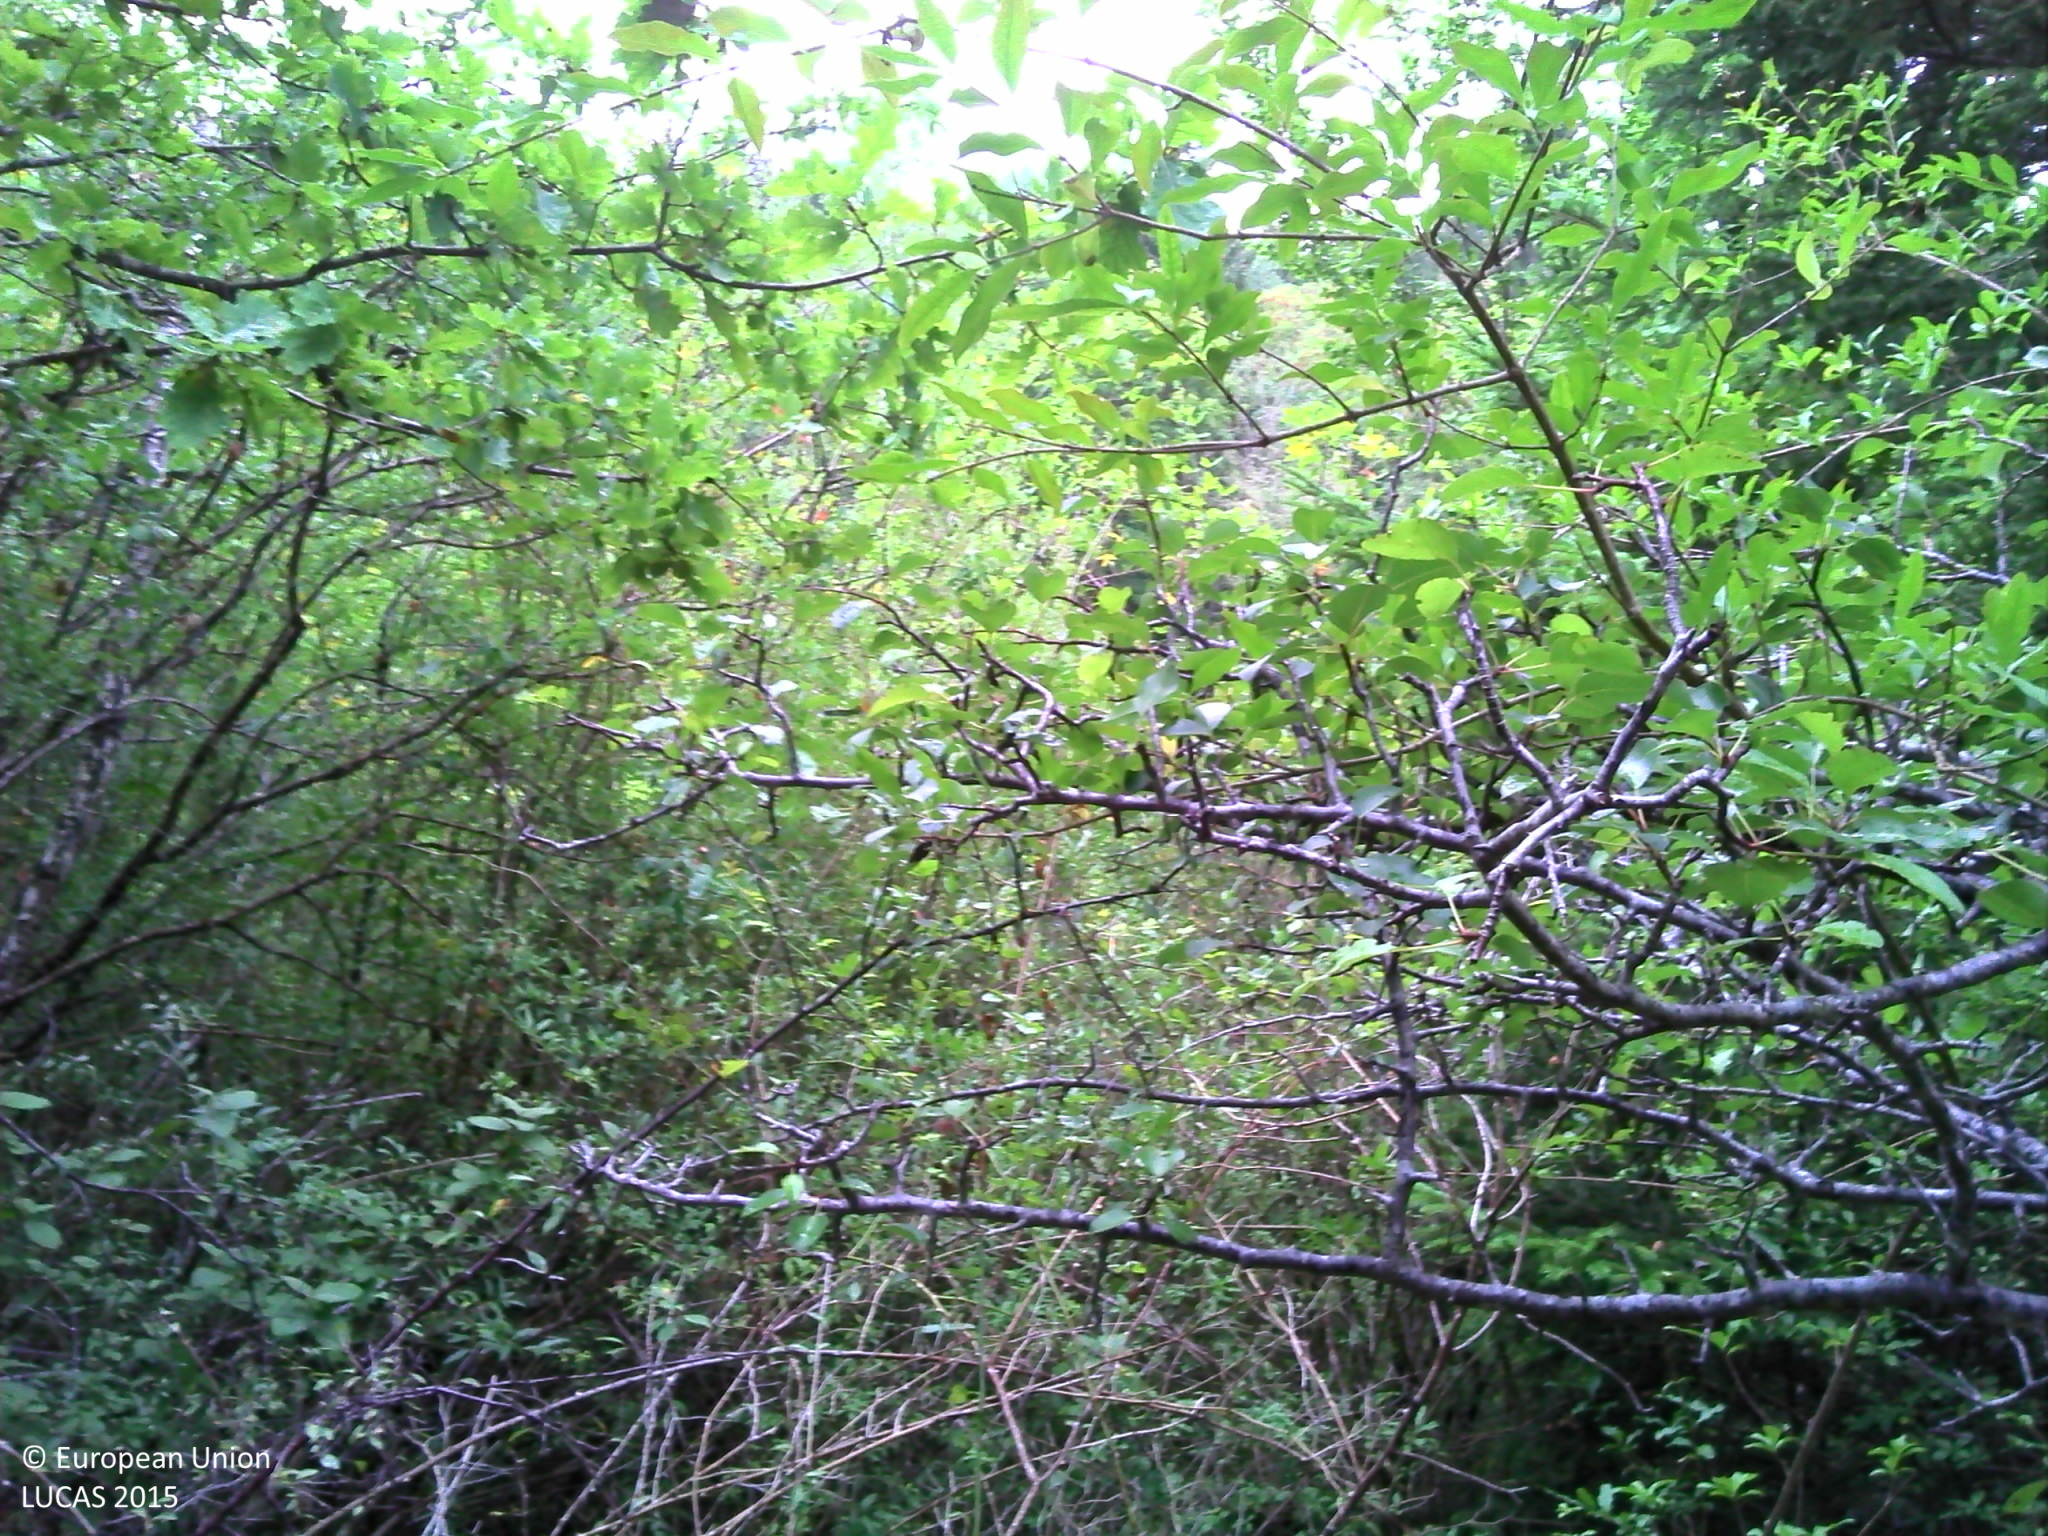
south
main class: Woodland
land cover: Broadleaved woodland
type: acidophilous oak and oak-birch forest
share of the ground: > 75 %
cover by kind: broadleaved forest trees 85 %, shrubs 5 %, herbaceous plants 5 %, lichens and mosses 5 %
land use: Forestry
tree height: > 5 m
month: August
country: FR
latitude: 47.8591
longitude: 4.2904
